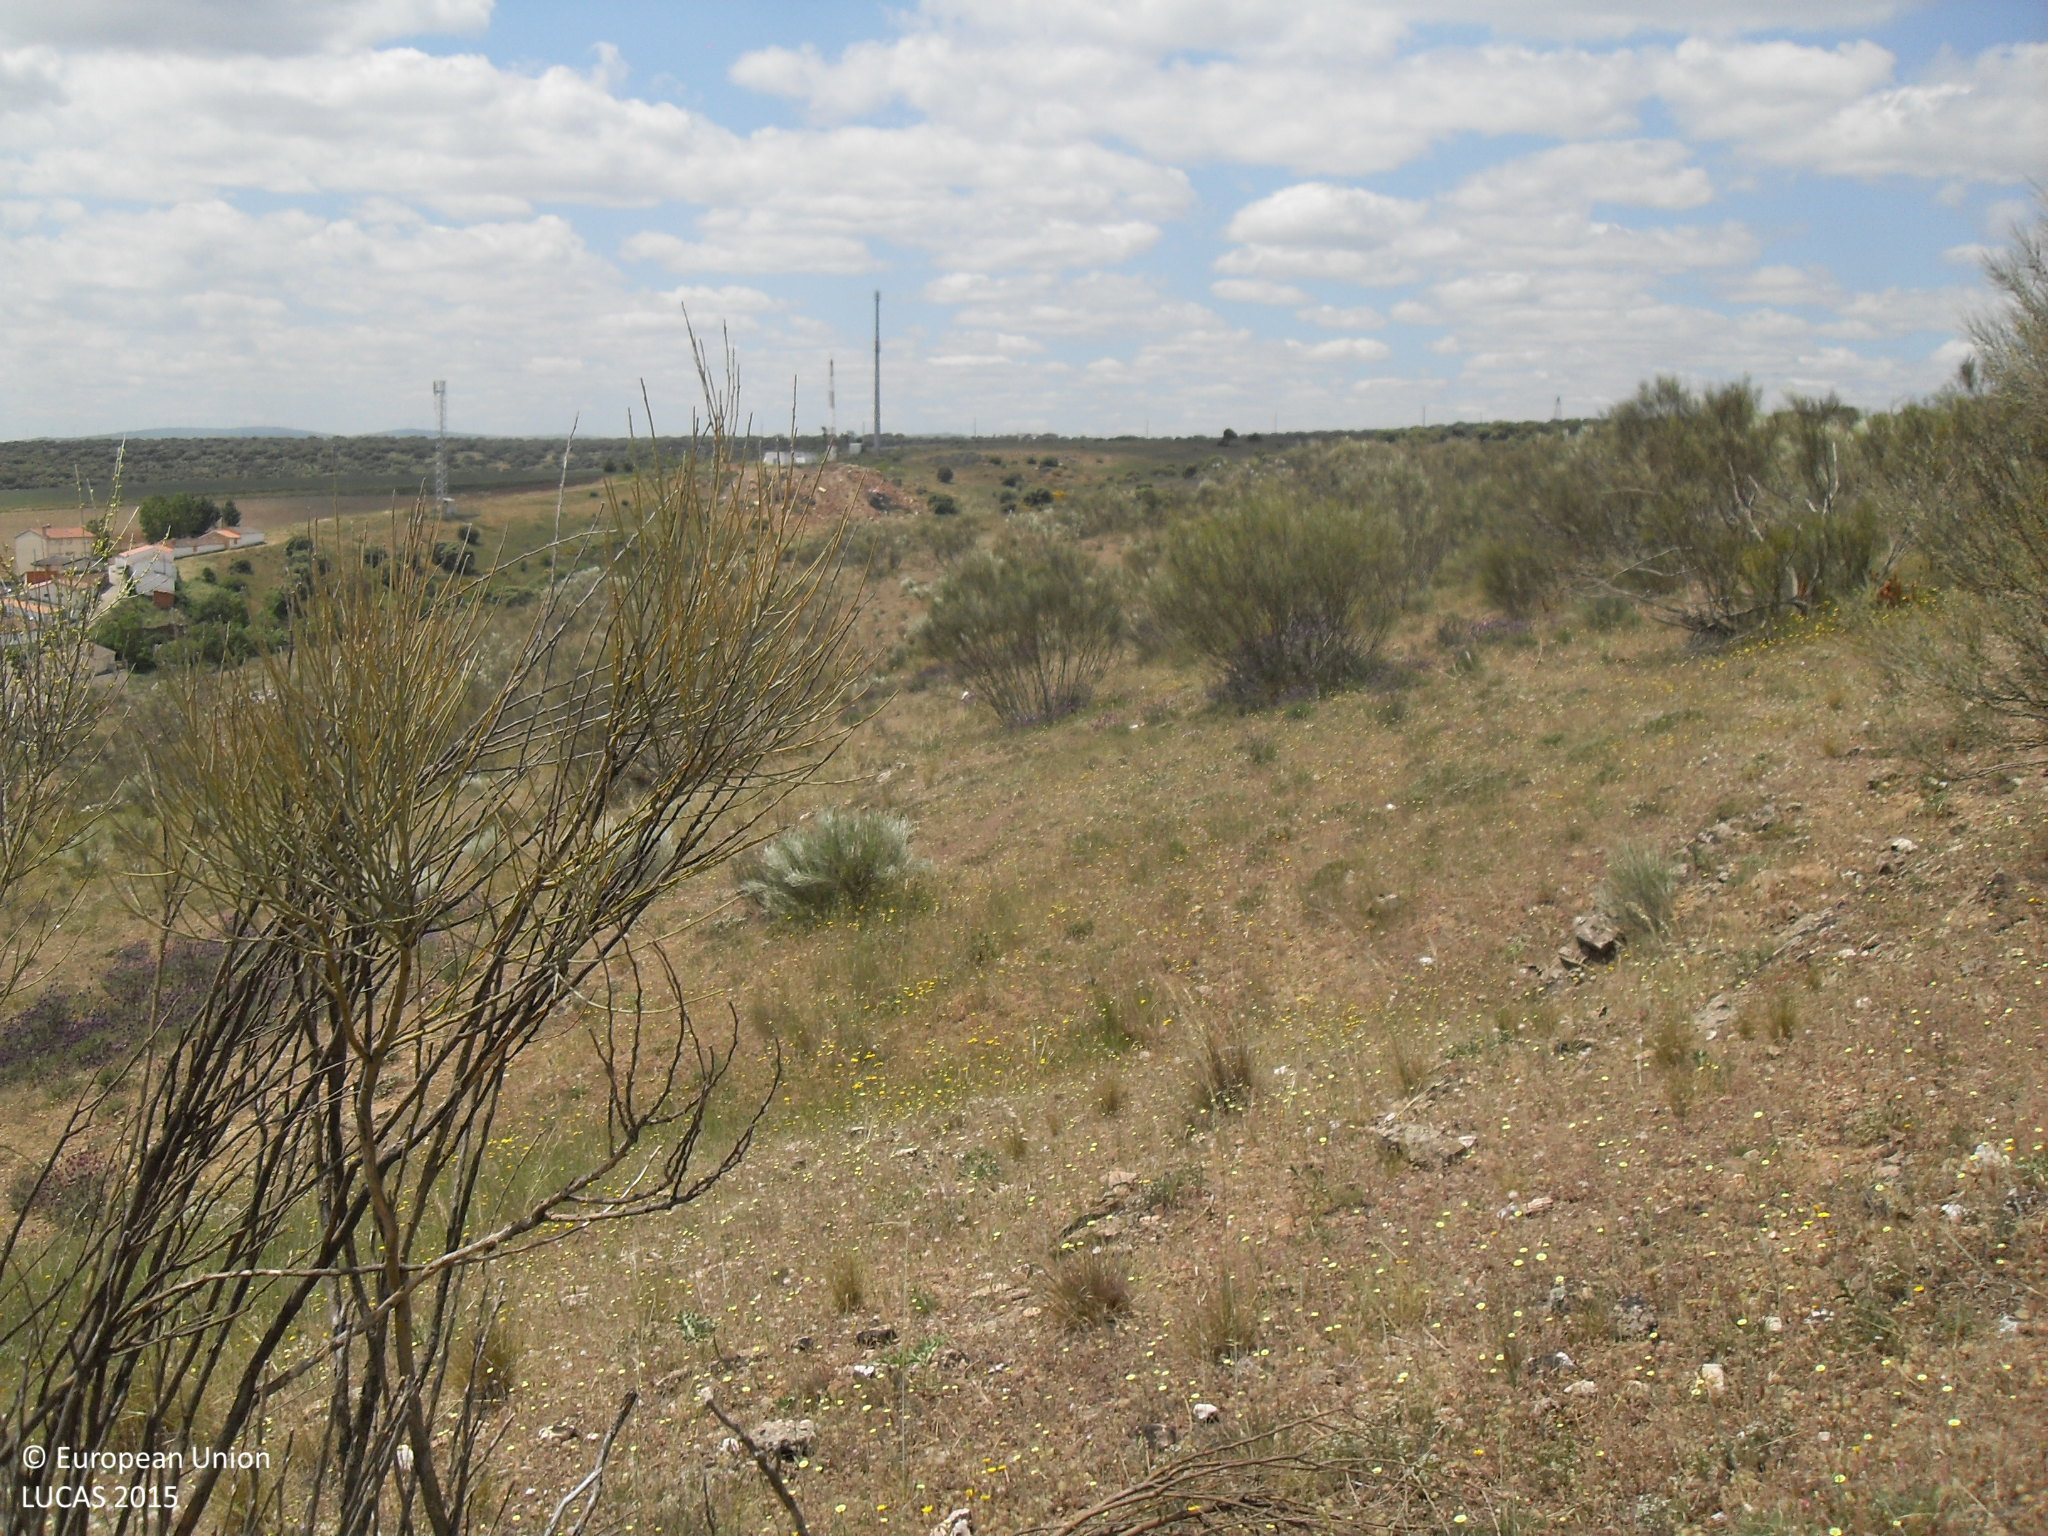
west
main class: Shrubland
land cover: Shrubland without tree cover
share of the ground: 10 - 25 %
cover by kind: herbaceous plants 80 %, shrubs 20 %
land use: Agriculture (excluding fallow land and kitchen gardens)
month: May
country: ES
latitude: 40.7531
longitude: -5.6251
